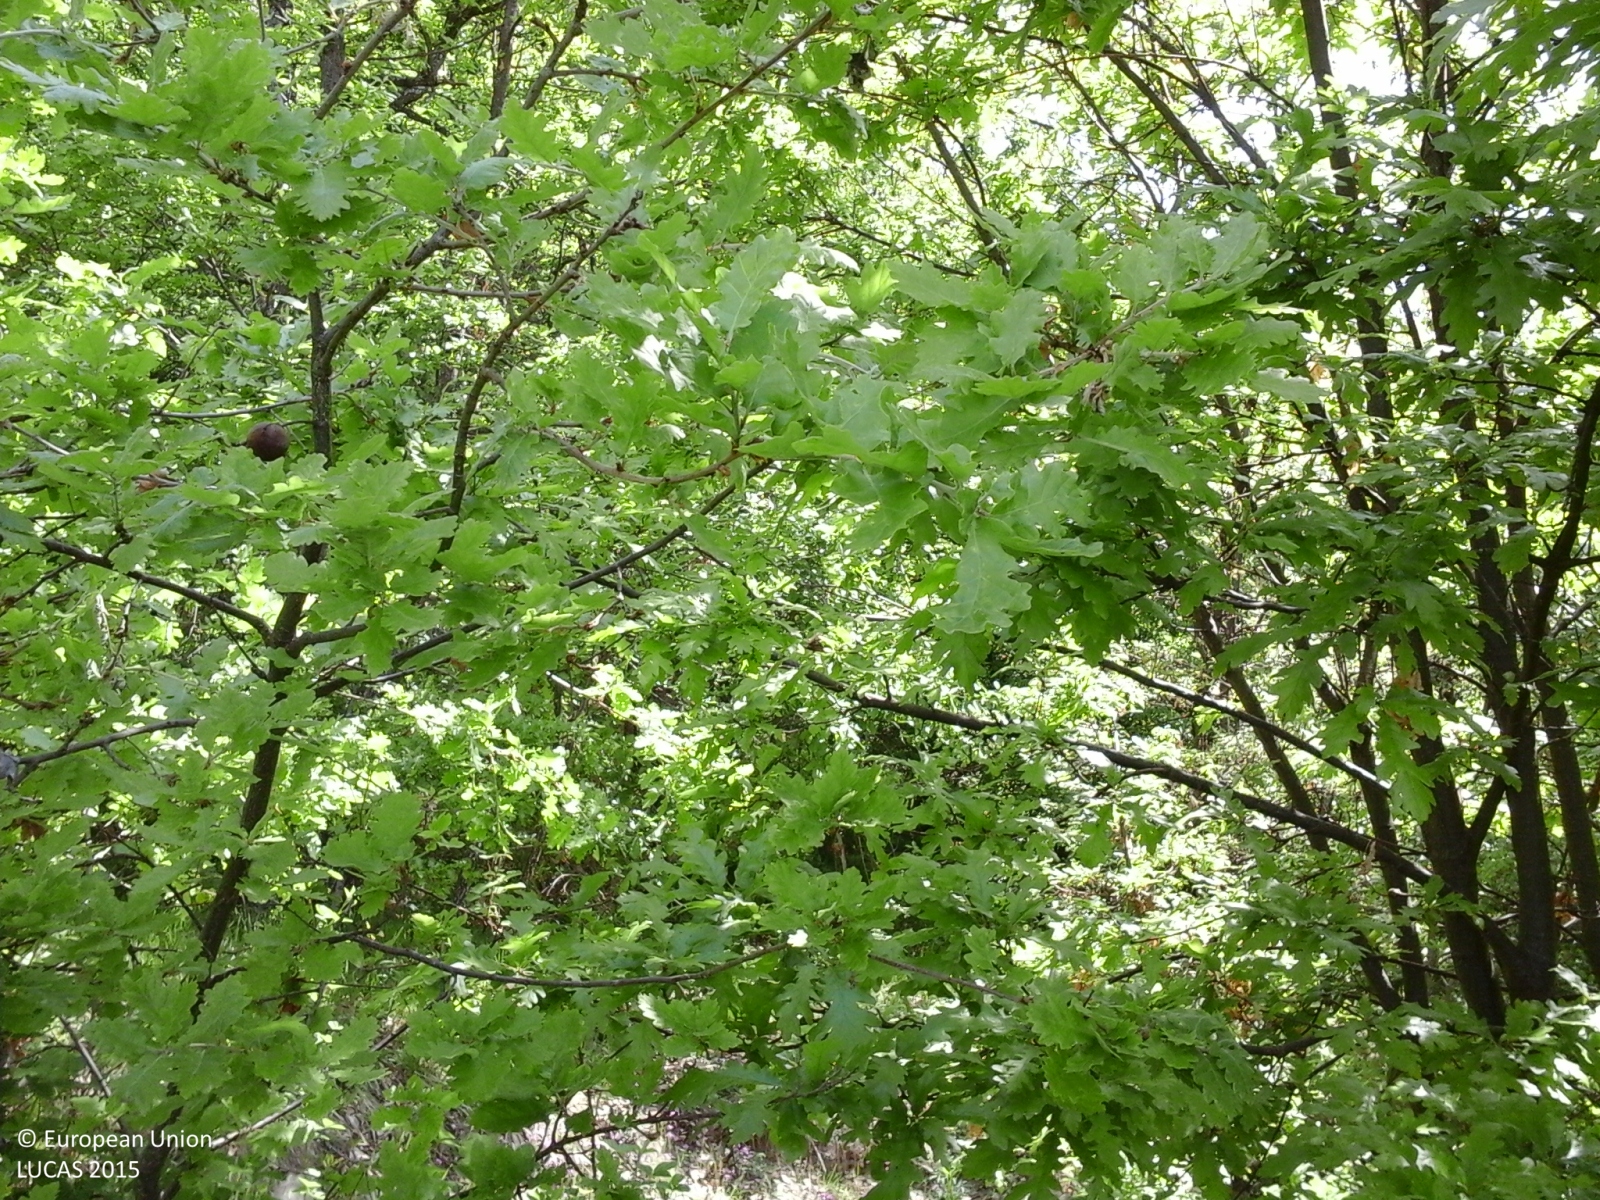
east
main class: Woodland
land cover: Broadleaved woodland
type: thermophilous deciduous forest
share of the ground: > 75 %
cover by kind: broadleaved forest trees 70 %, shrubs 20 %, herbaceous plants 10 %
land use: Forestry
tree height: > 5 m
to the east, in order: Broadleaved woodland; Tracks; Broadleaved woodland; Paved roads, cycling and walking lanes; Pine dominated coniferous woodland
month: May
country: IT
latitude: 44.7283
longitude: 9.5590
